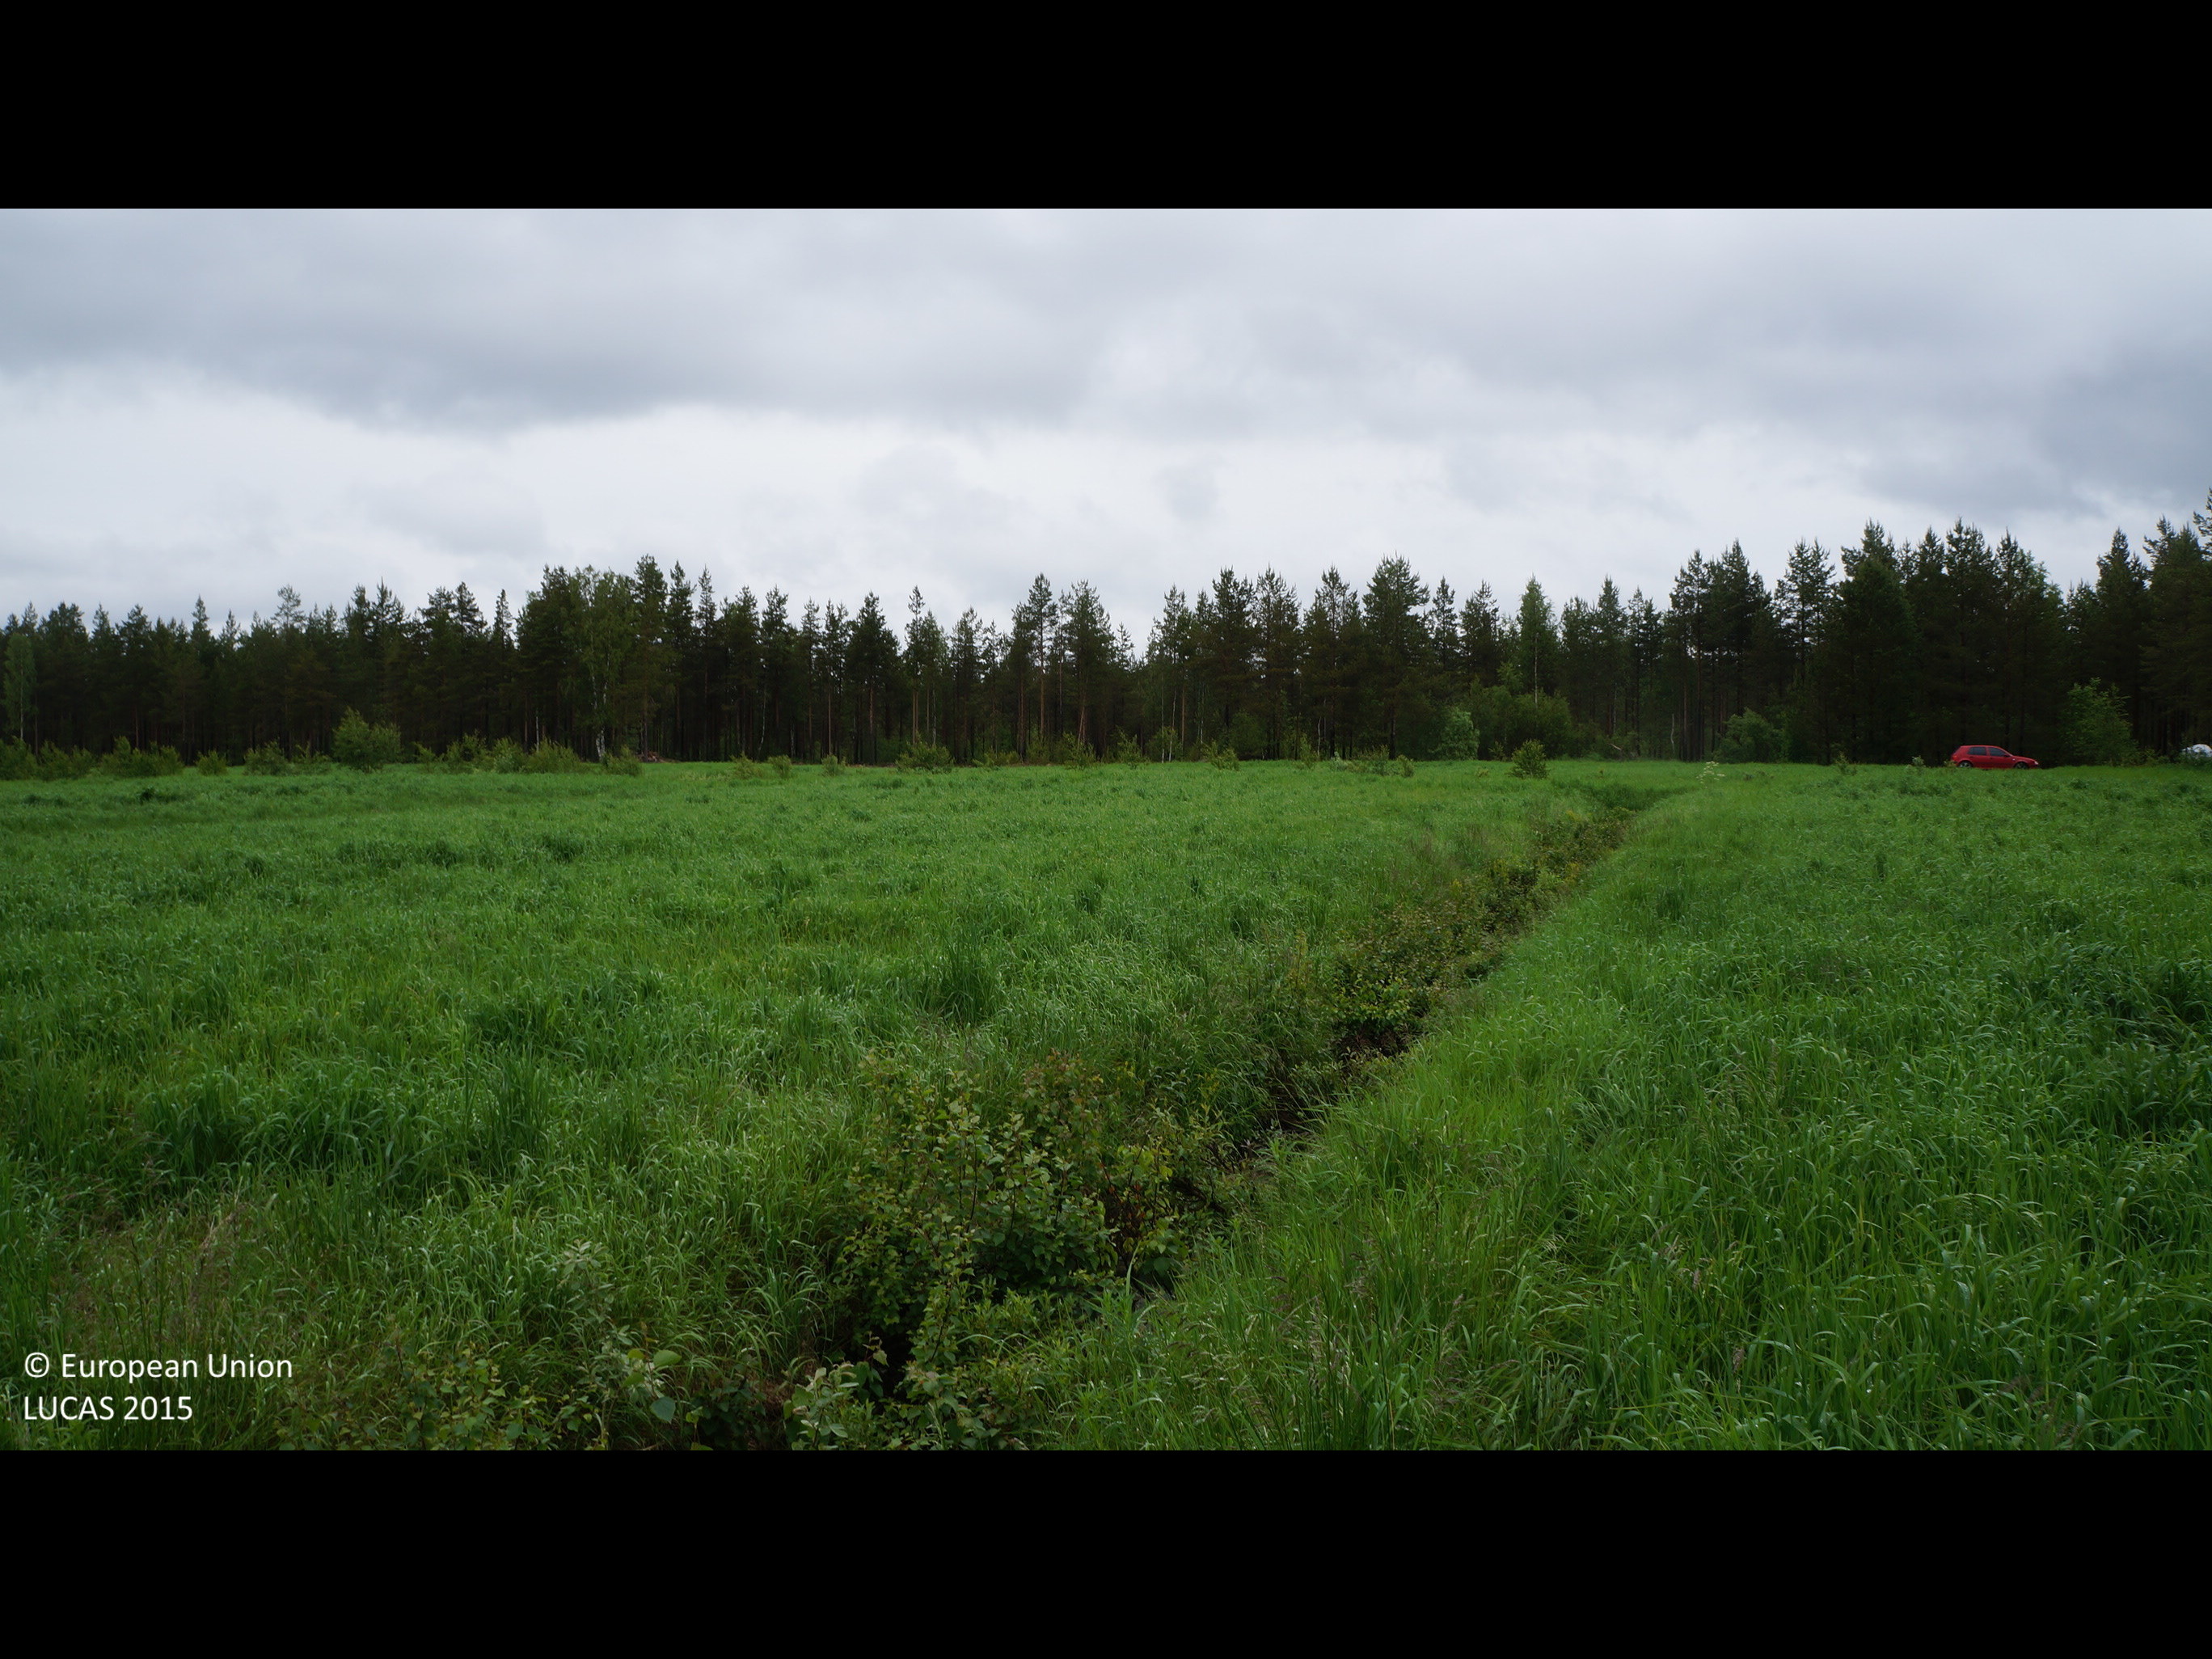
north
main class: Cropland
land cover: Temporary grasslands
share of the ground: > 75 %
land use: Agriculture (excluding fallow land and kitchen gardens)
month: June
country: FI
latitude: 64.6612
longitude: 25.3513
